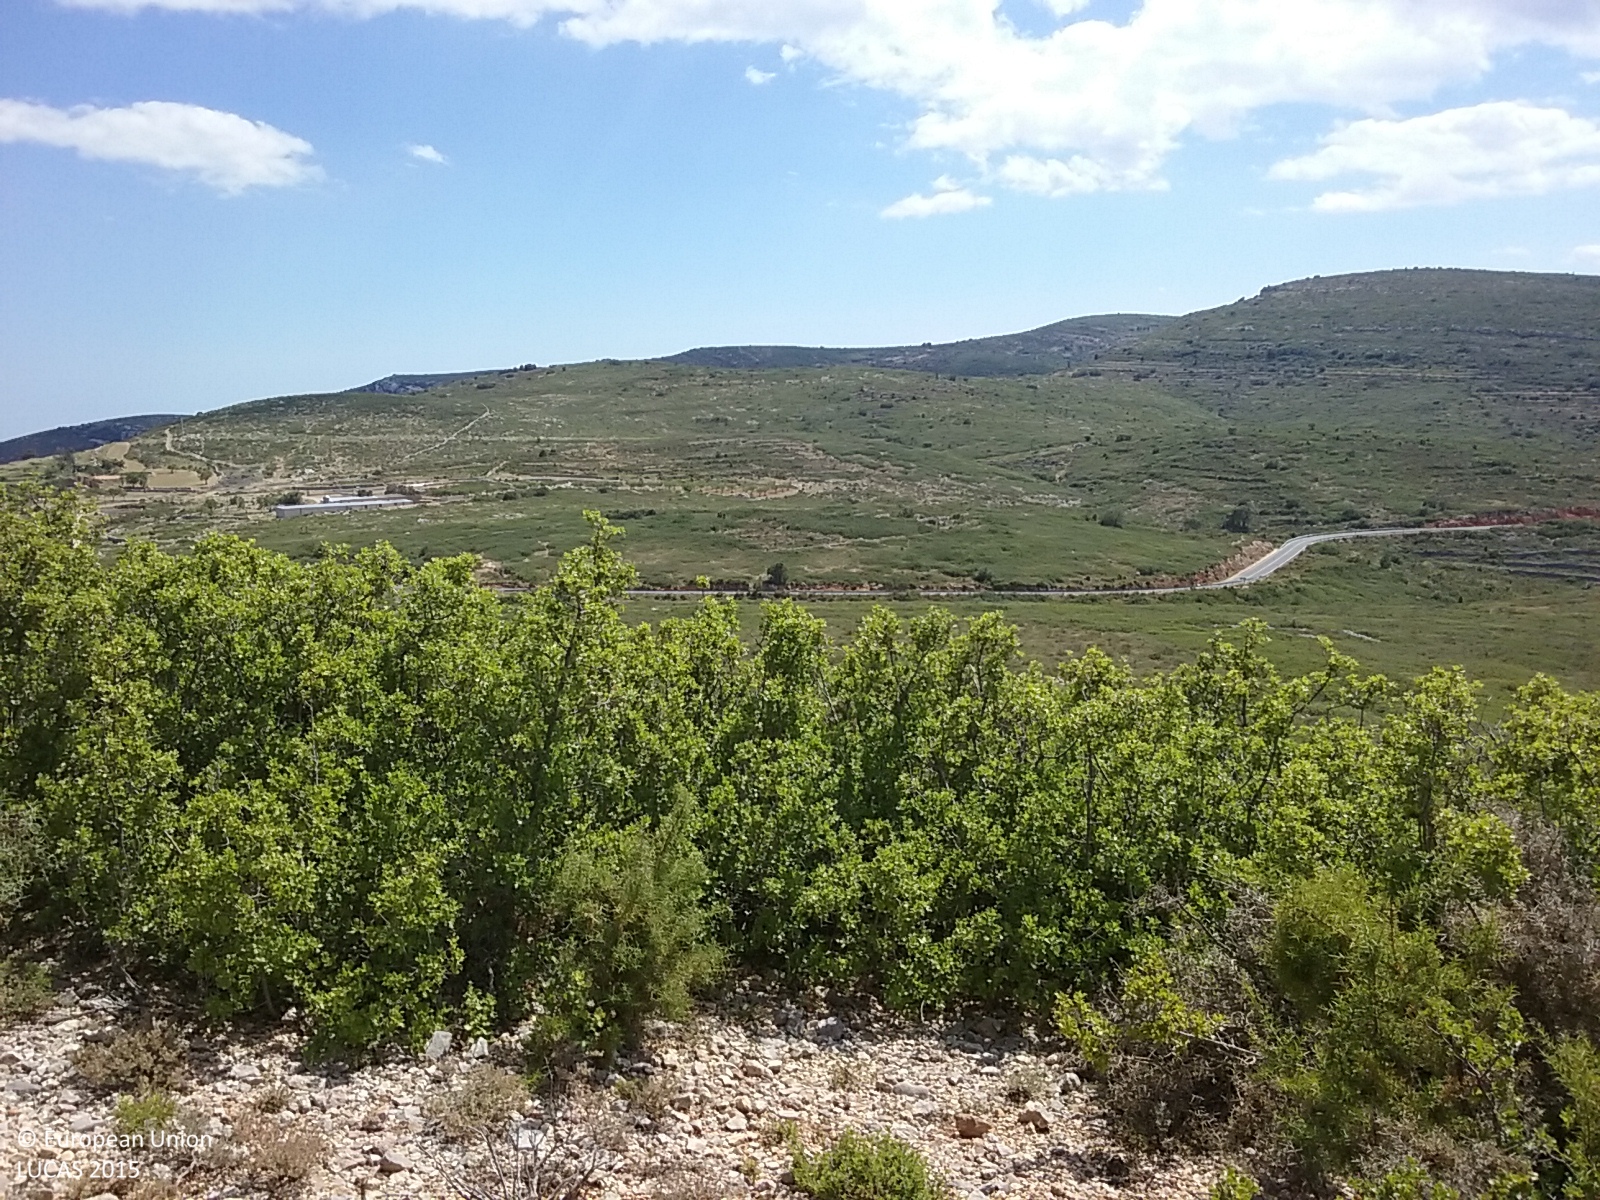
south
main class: Shrubland
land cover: Shrubland without tree cover
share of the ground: > 75 %
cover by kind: shrubs 90 %
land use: Semi-natural and natural areas not in use
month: May
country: ES
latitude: 40.3633
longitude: 0.0688
